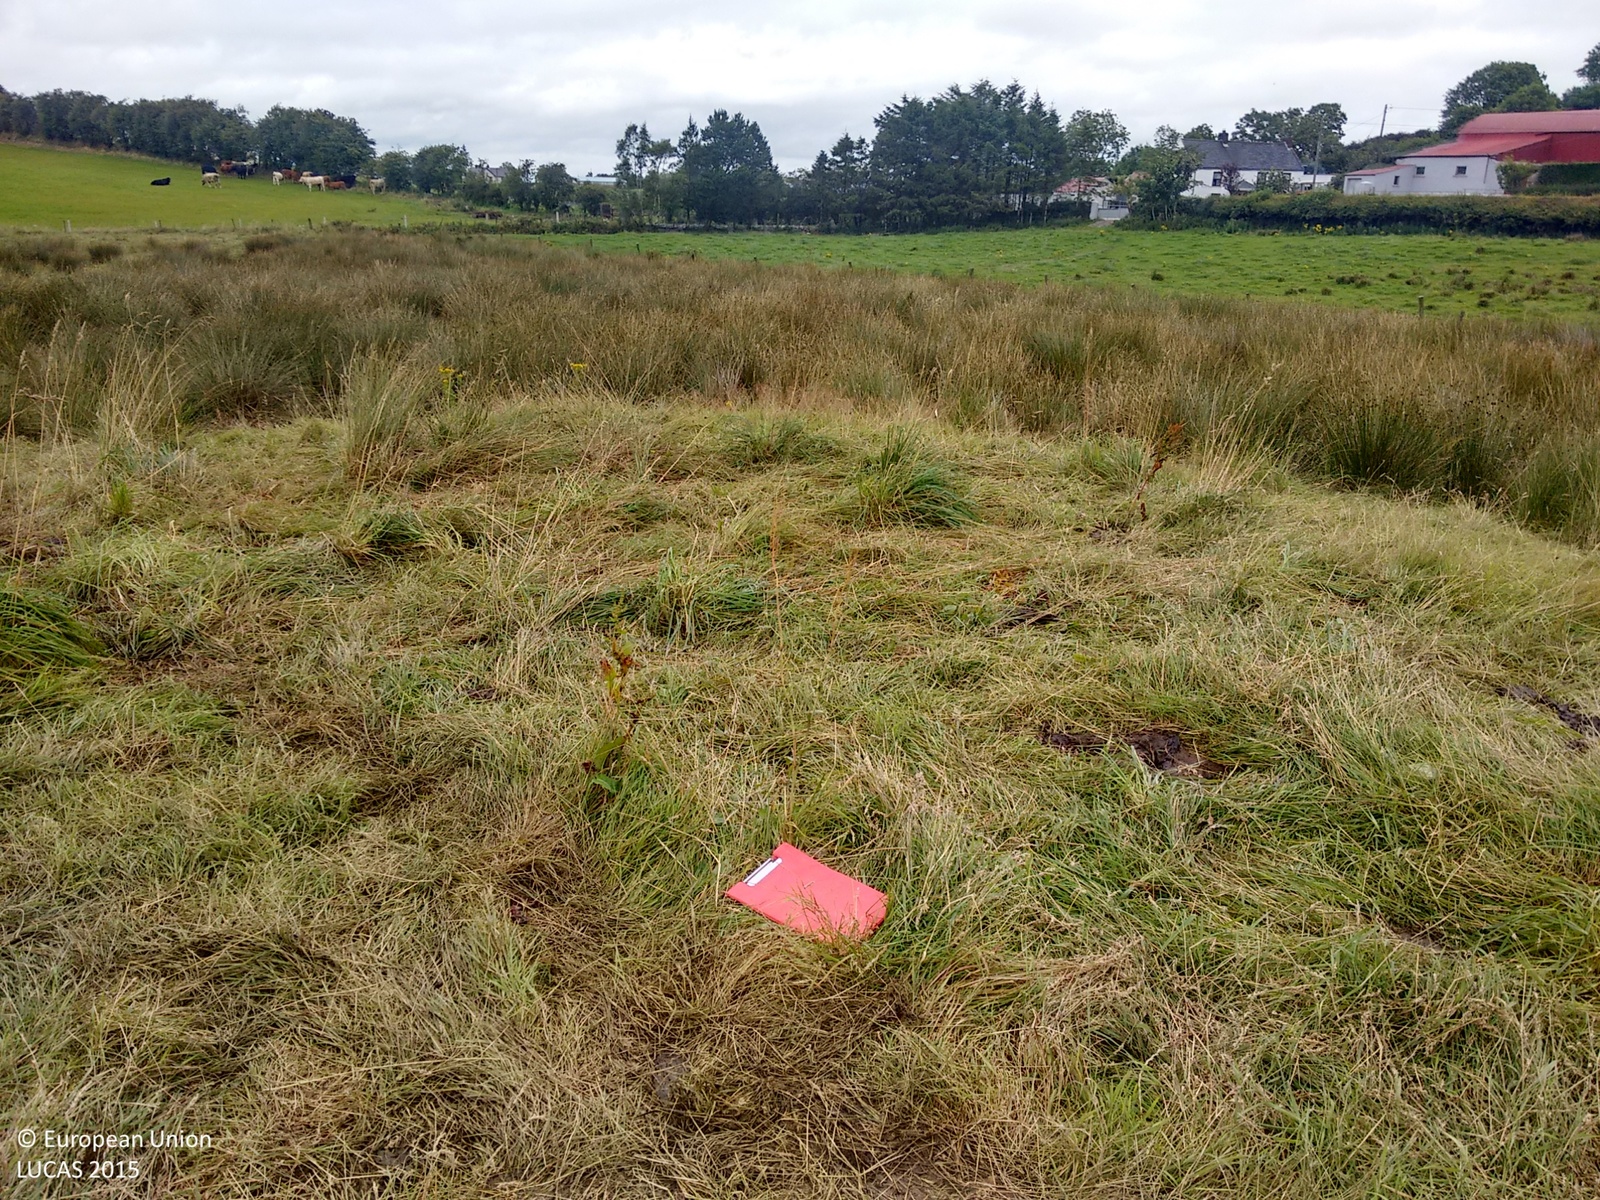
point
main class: Grassland
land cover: Grassland with sparse tree/shrub cover
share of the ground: > 75 %
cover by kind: herbaceous plants 95 %, broadleaved forest trees 5 %
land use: Agriculture (excluding fallow land and kitchen gardens)
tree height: < 5 m
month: August
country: IE
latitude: 54.0901
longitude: -6.8149
